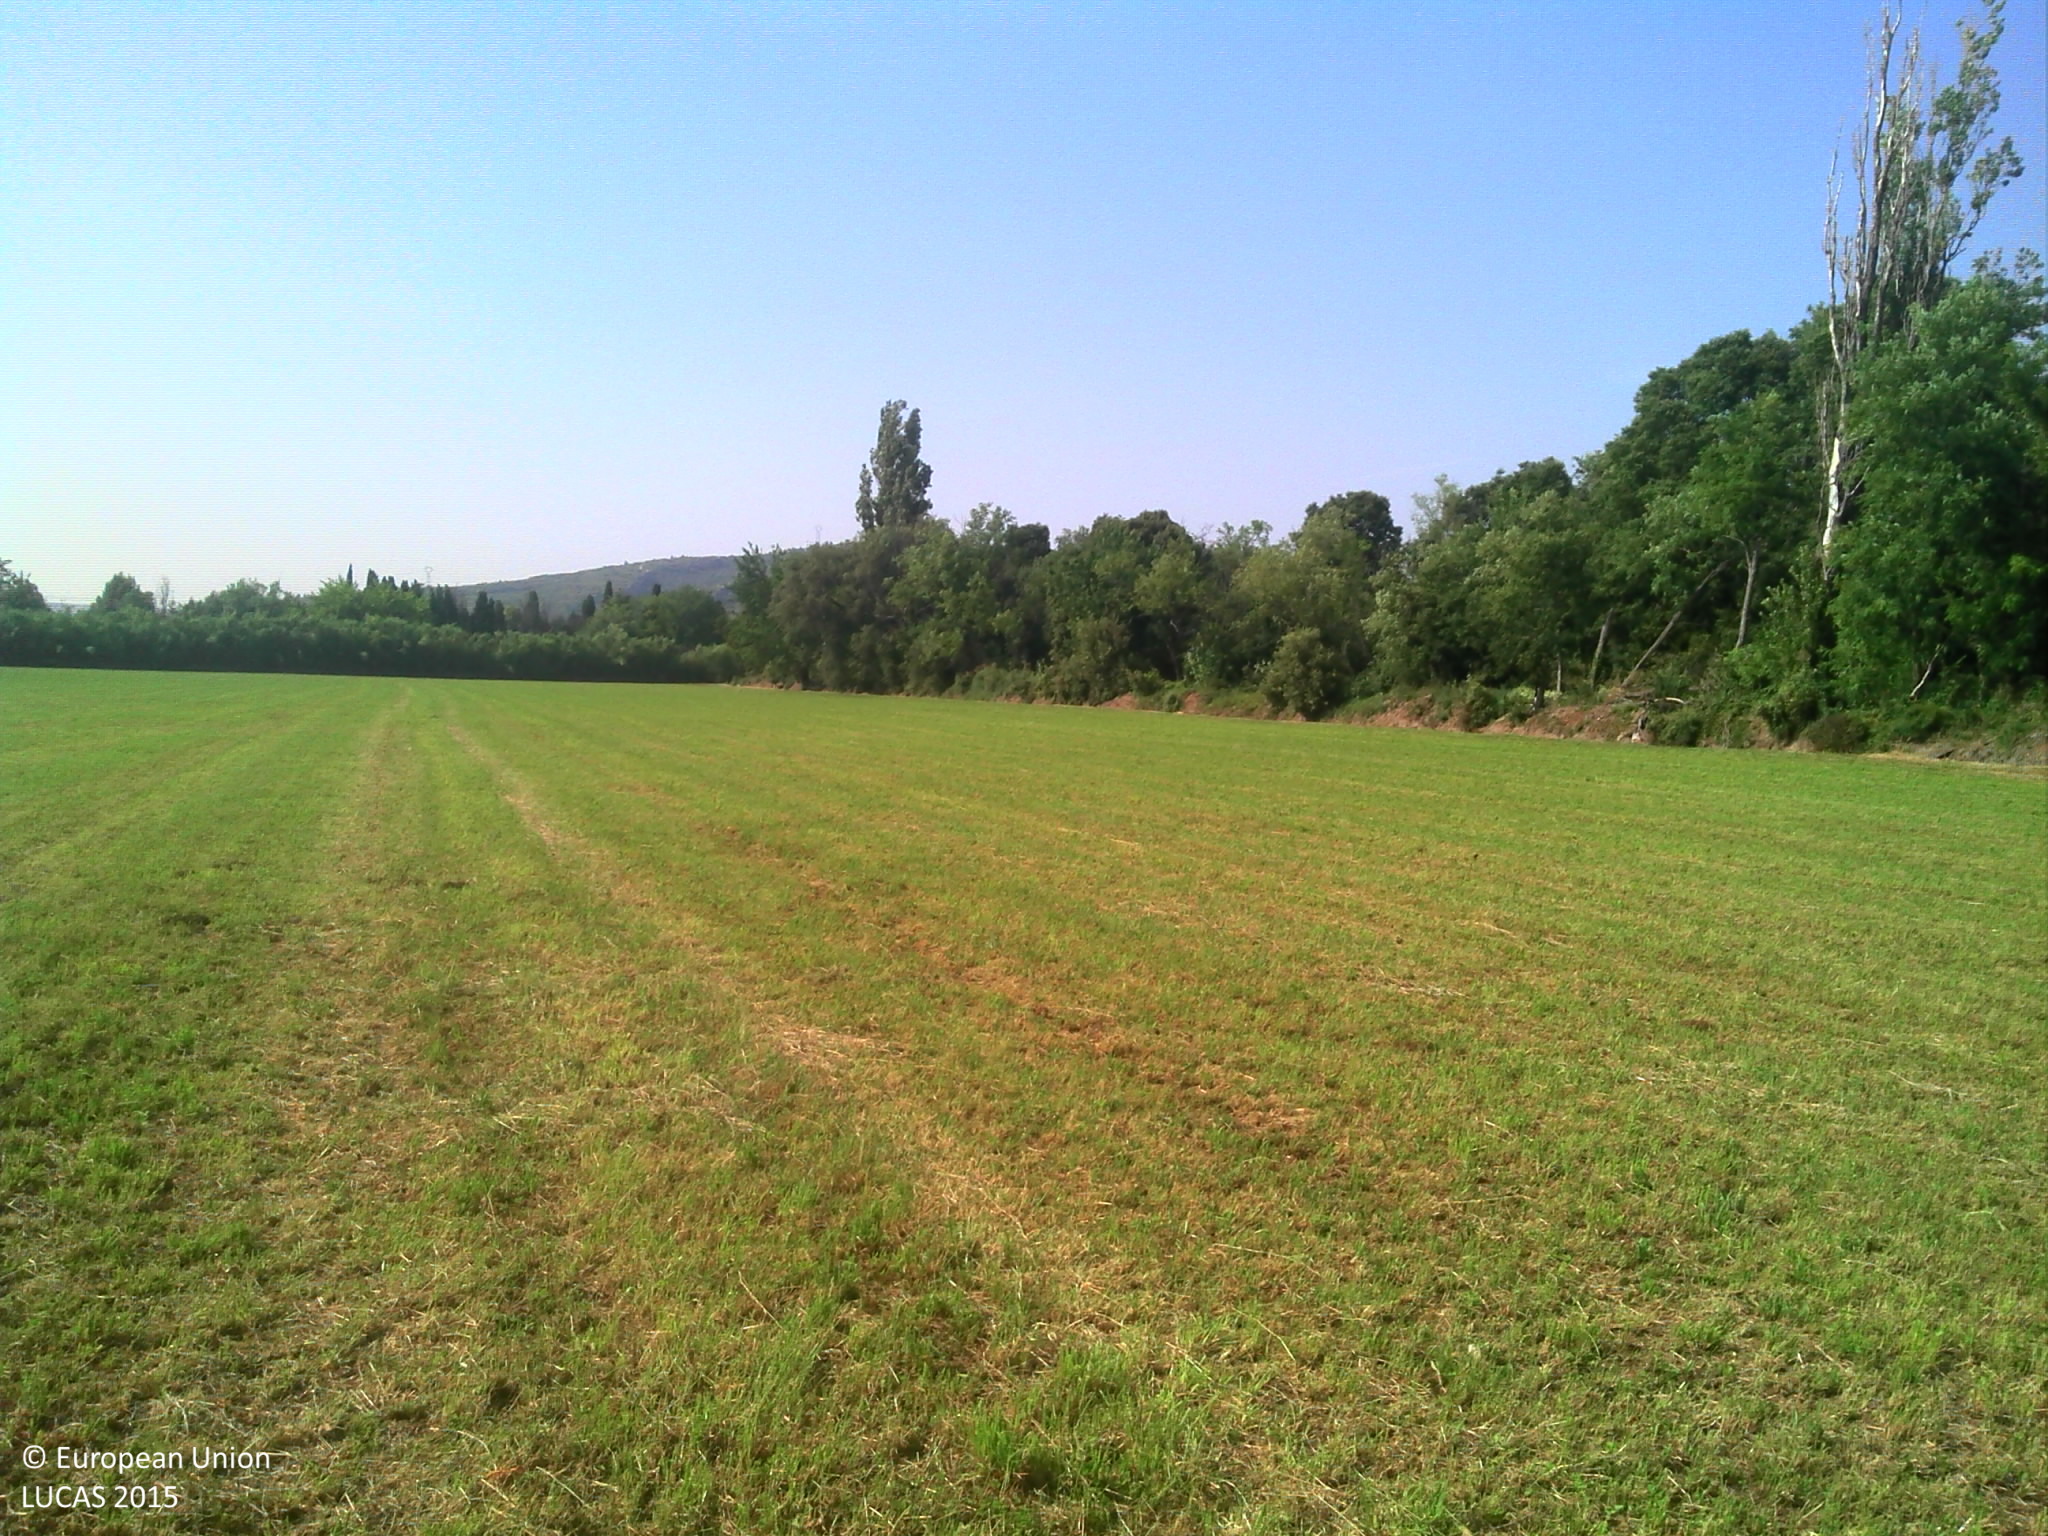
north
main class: Grassland
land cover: Grassland without tree/shrub cover
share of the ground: > 75 %
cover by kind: herbaceous plants 100 %
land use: Agriculture (excluding fallow land and kitchen gardens)
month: July
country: FR
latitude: 43.6728
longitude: 5.0607
